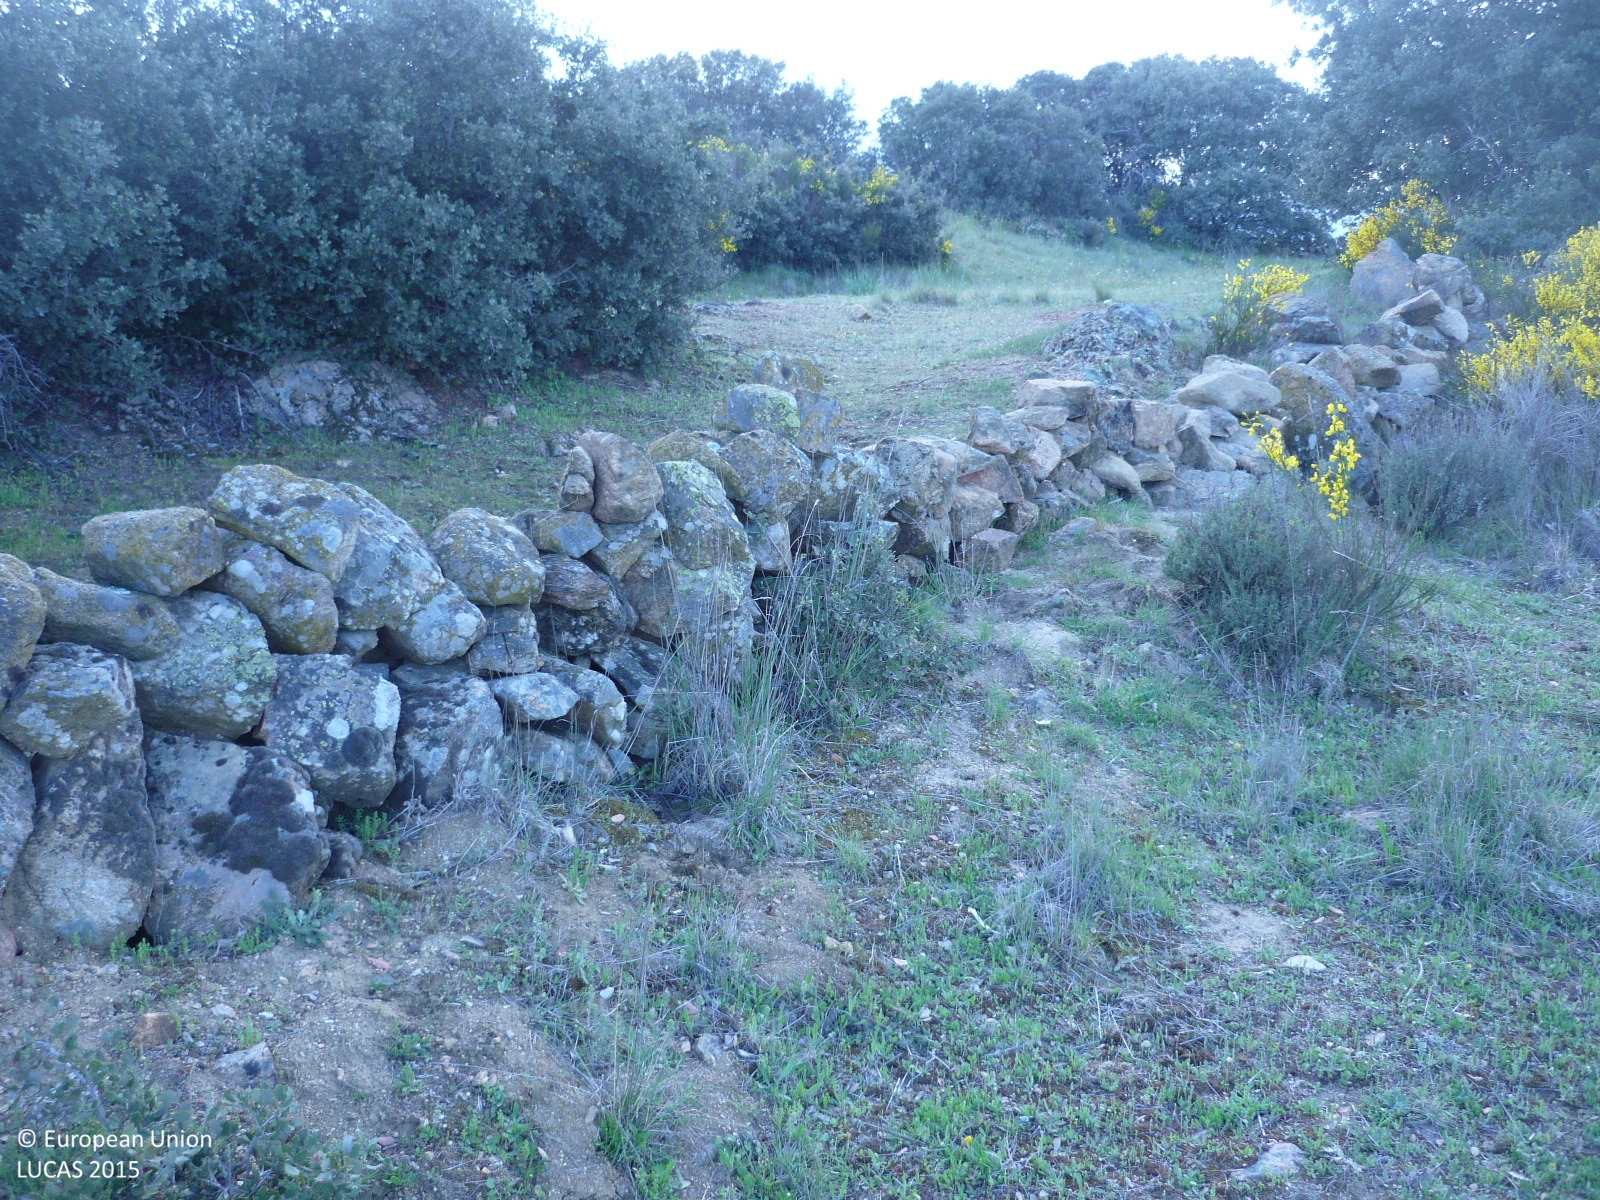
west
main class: Grassland
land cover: Grassland with sparse tree/shrub cover
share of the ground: > 75 %
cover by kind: herbaceous plants 85 %, shrubs 10 %, broadleaved forest trees 5 %
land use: Agriculture (excluding fallow land and kitchen gardens)
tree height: > 5 m
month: April
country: ES
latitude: 40.7794
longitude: -3.6081
